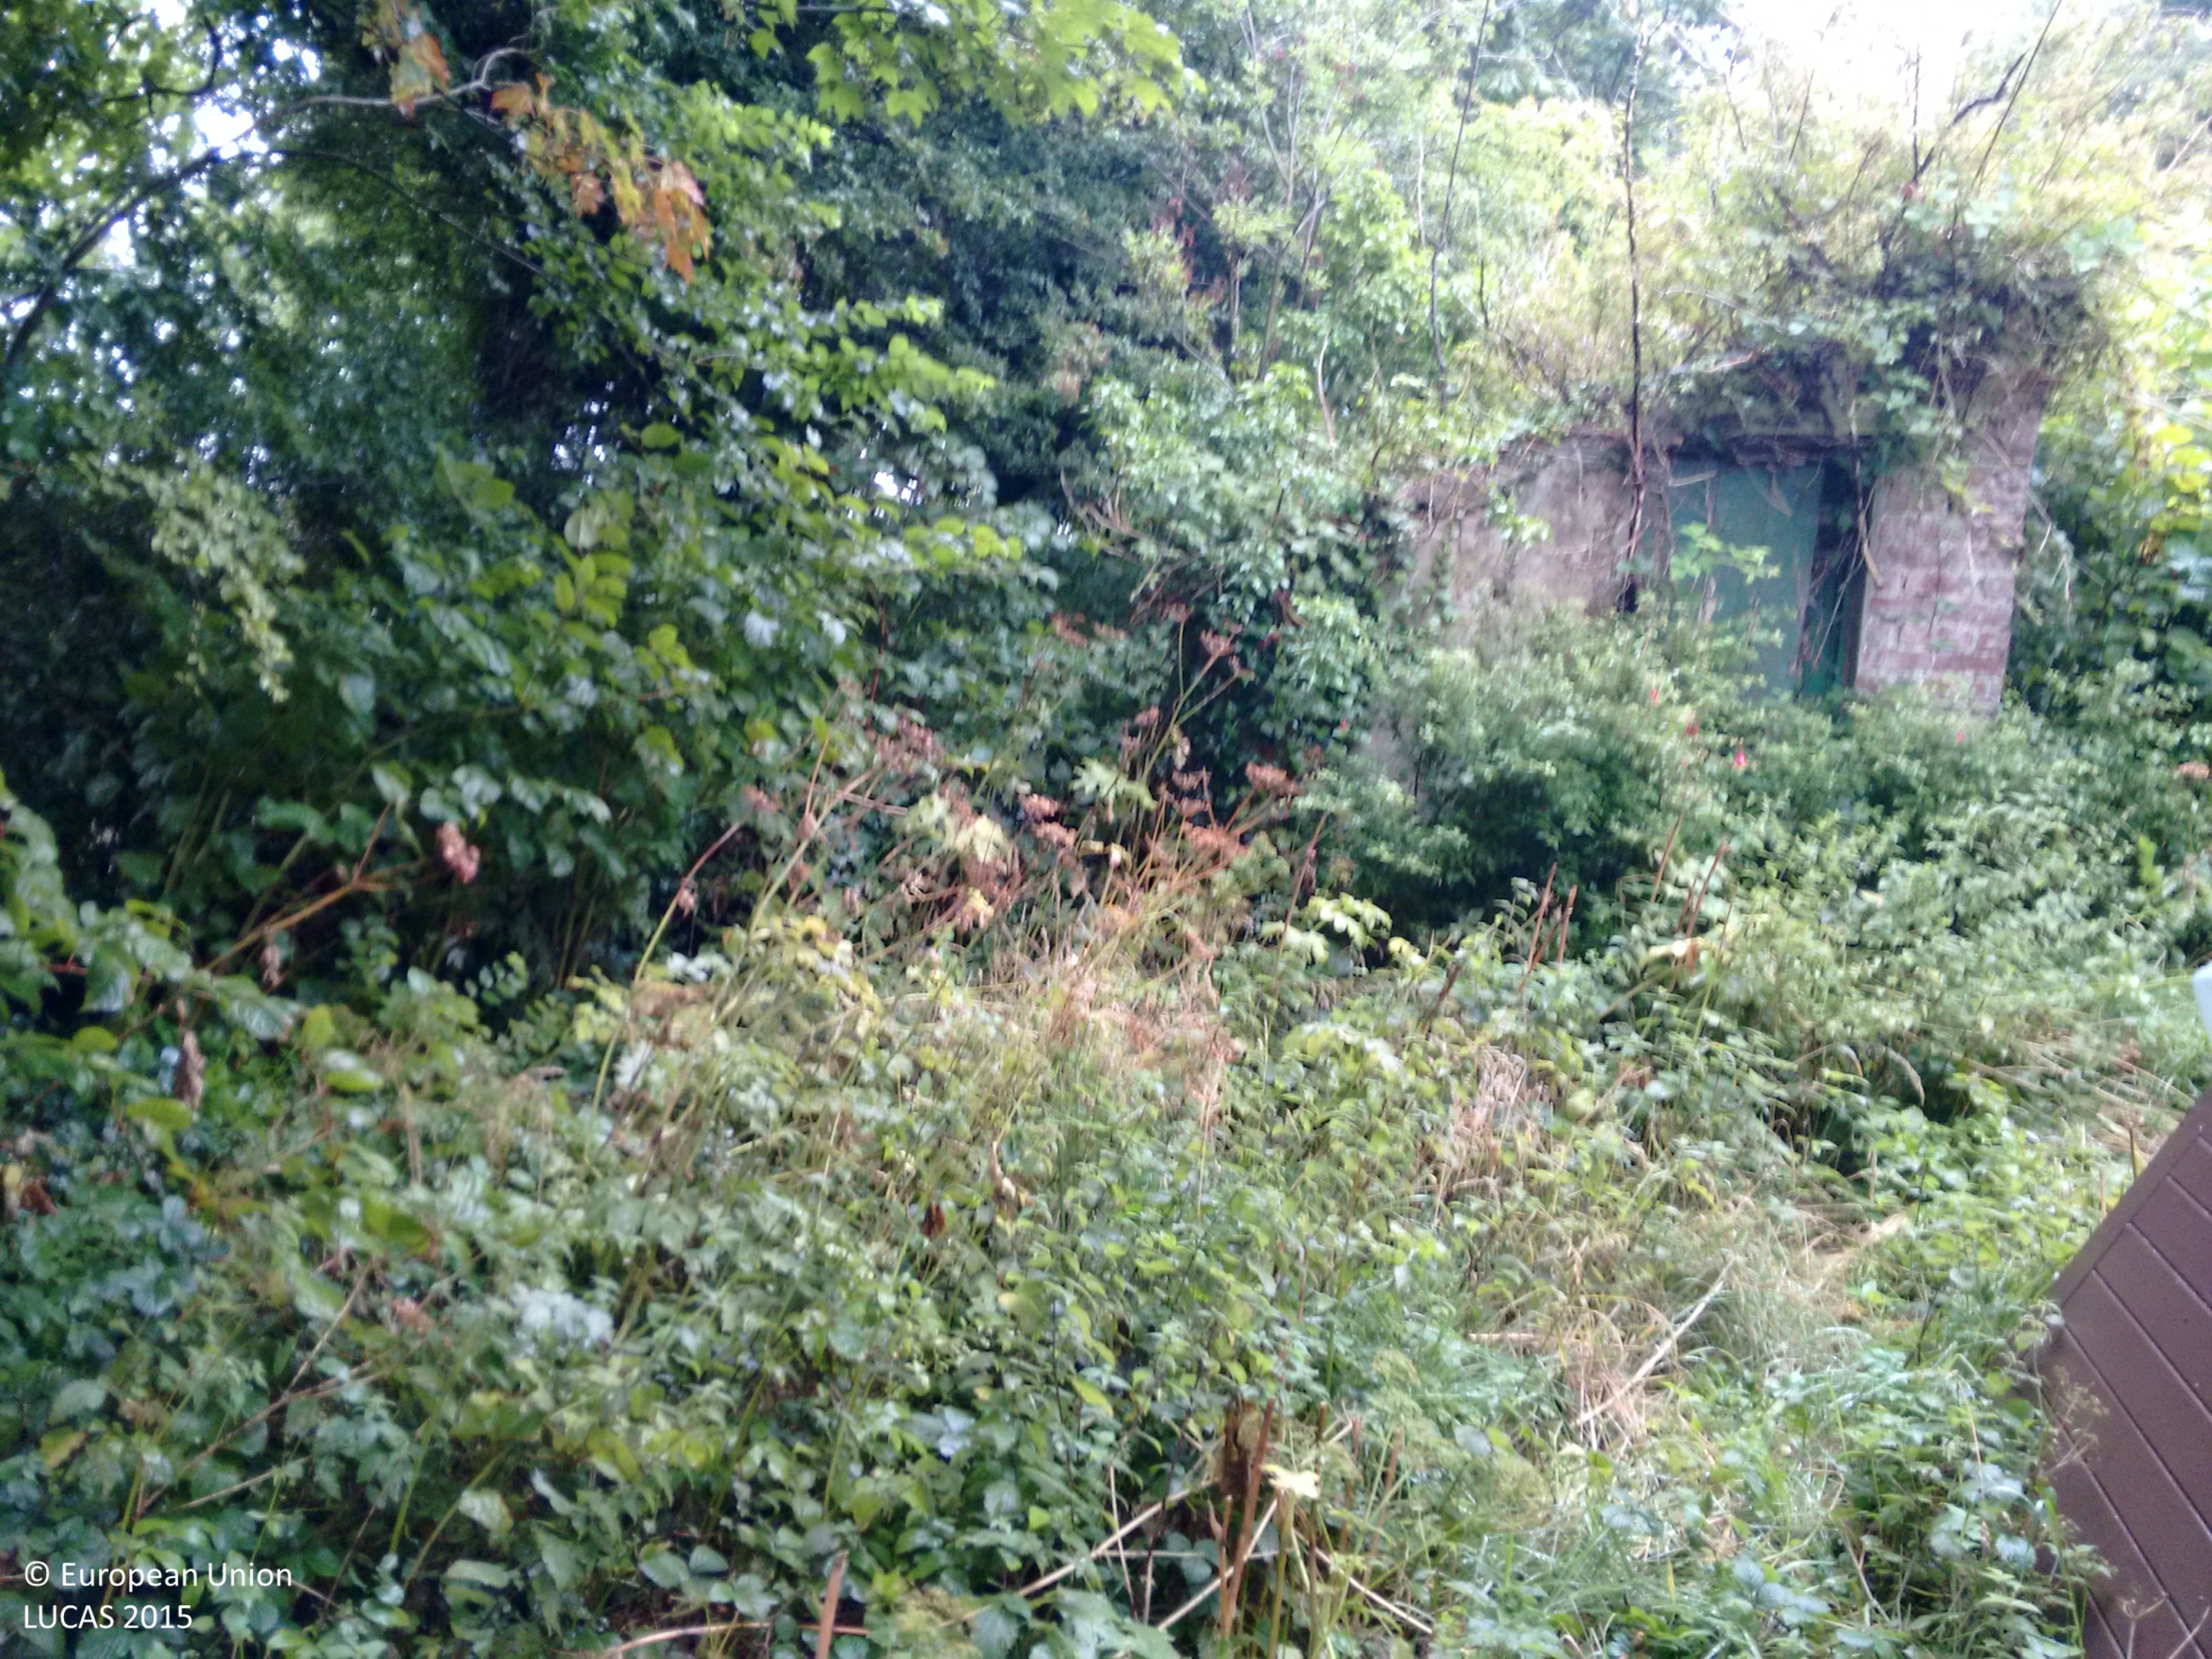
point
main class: Woodland
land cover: Broadleaved woodland
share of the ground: > 75 %
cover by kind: broadleaved forest trees 95 %, herbaceous plants 5 %
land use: Residential
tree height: > 5 m
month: August
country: IE
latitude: 52.4836
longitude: -6.3356
